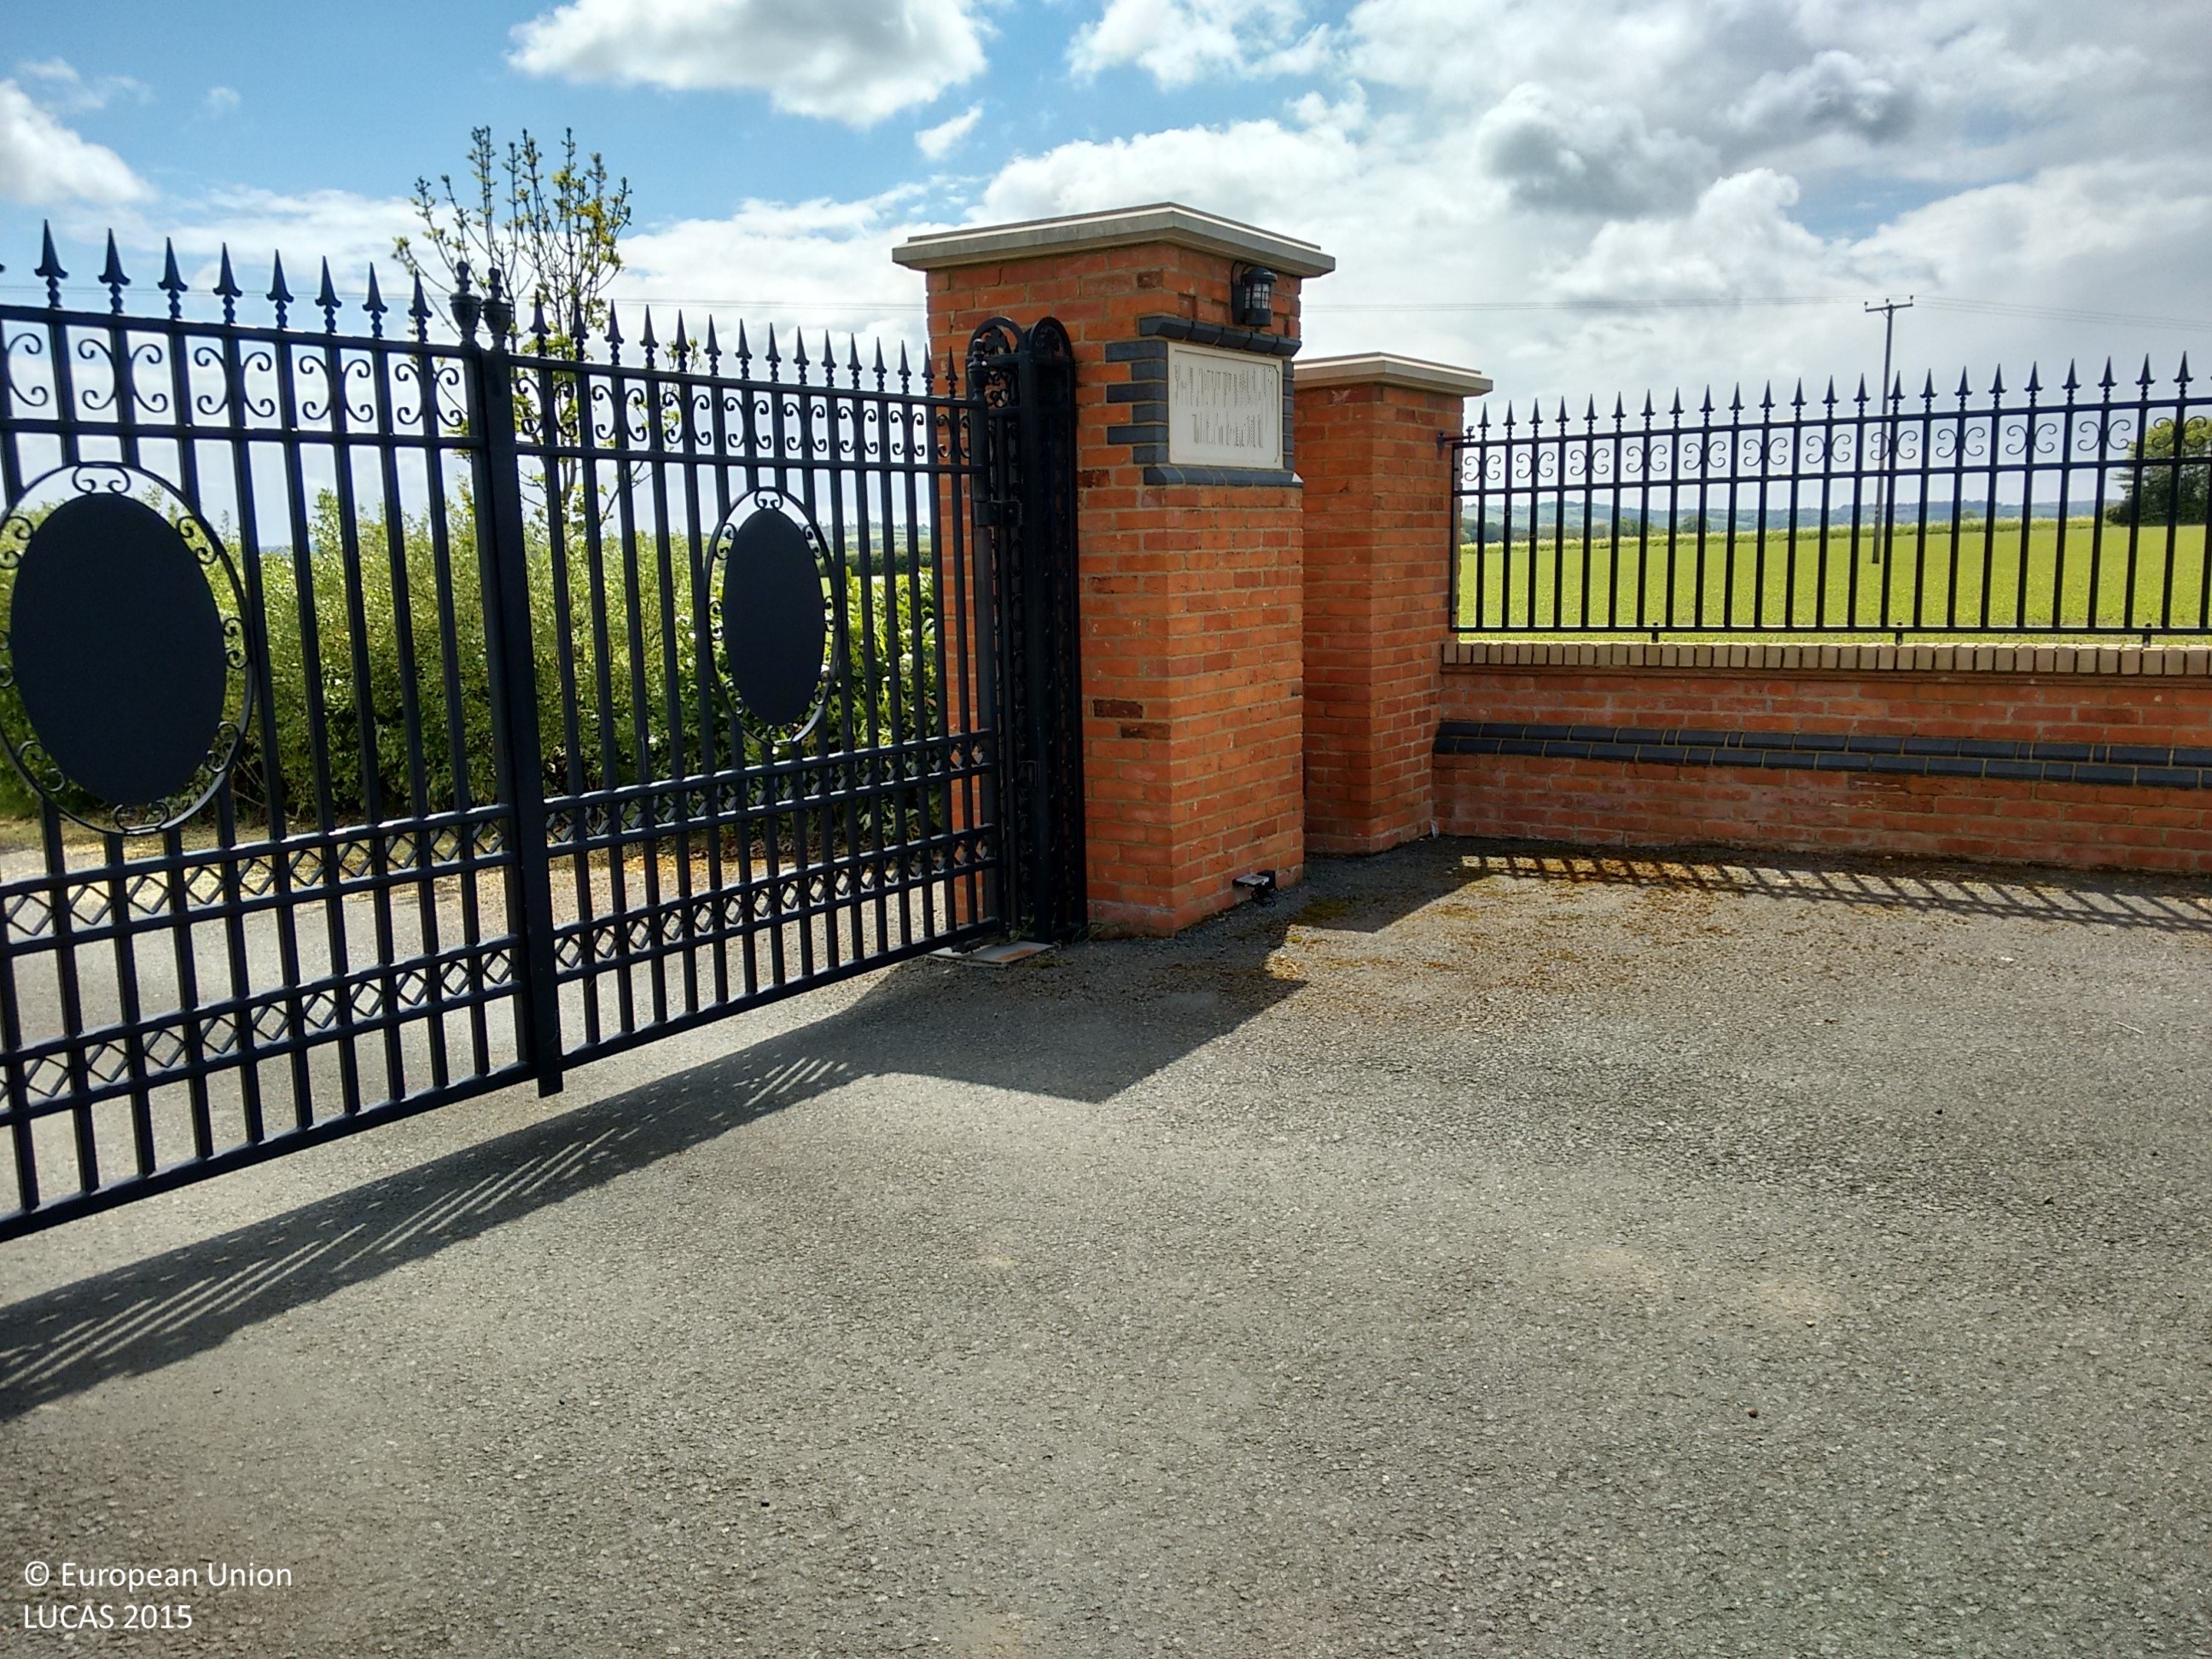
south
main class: Cropland
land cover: Dry pulses
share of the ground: 25 - 50 %
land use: Agriculture (excluding fallow land and kitchen gardens)
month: May
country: GB
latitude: 51.9978
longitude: -0.3339
